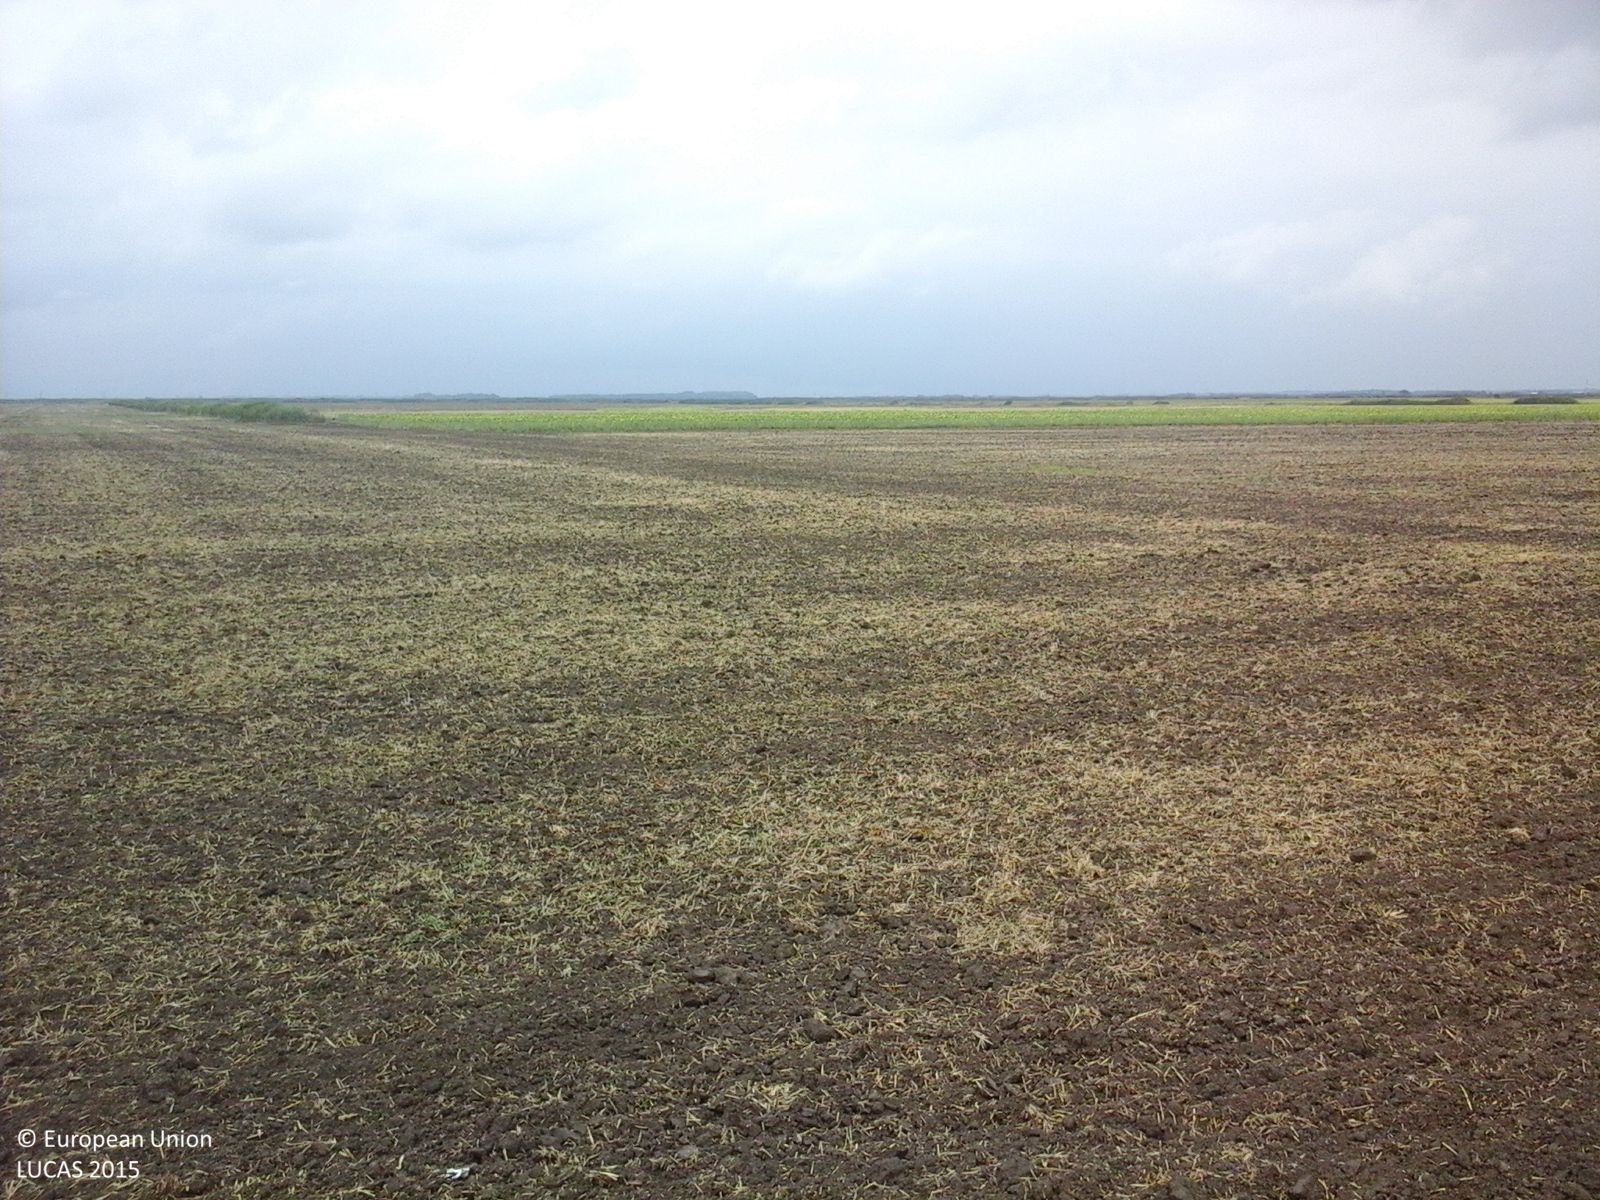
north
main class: Cropland
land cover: Sunflower
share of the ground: > 75 %
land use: Agriculture (excluding fallow land and kitchen gardens)
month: August
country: RO
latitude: 46.1241
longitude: 20.4942
